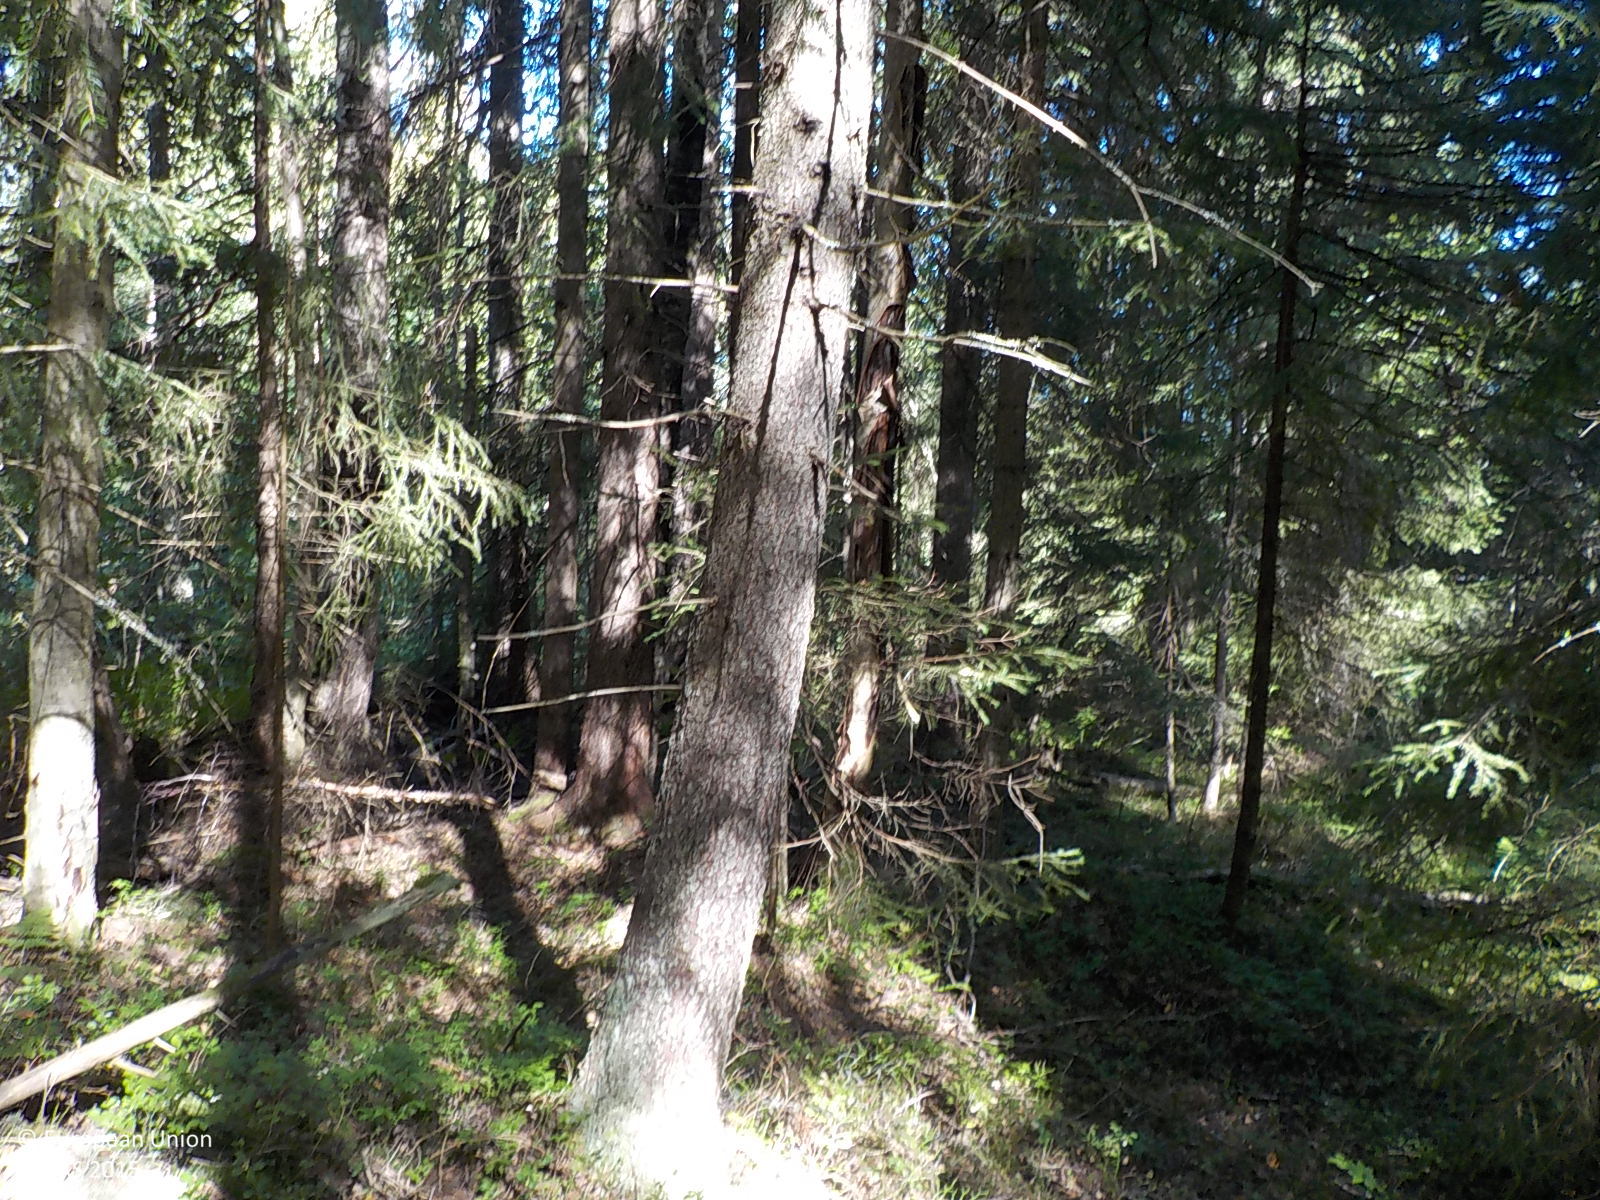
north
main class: Woodland
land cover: Spruce dominated coniferous woodland
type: boreal forest
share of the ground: > 75 %
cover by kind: coniferous forest trees 75 %, herbaceous plants 25 %
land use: Forestry
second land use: Amenities, museums, leisure
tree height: > 5 m
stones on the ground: 10 - 25 %
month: August
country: SE
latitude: 63.3050
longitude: 18.6971
